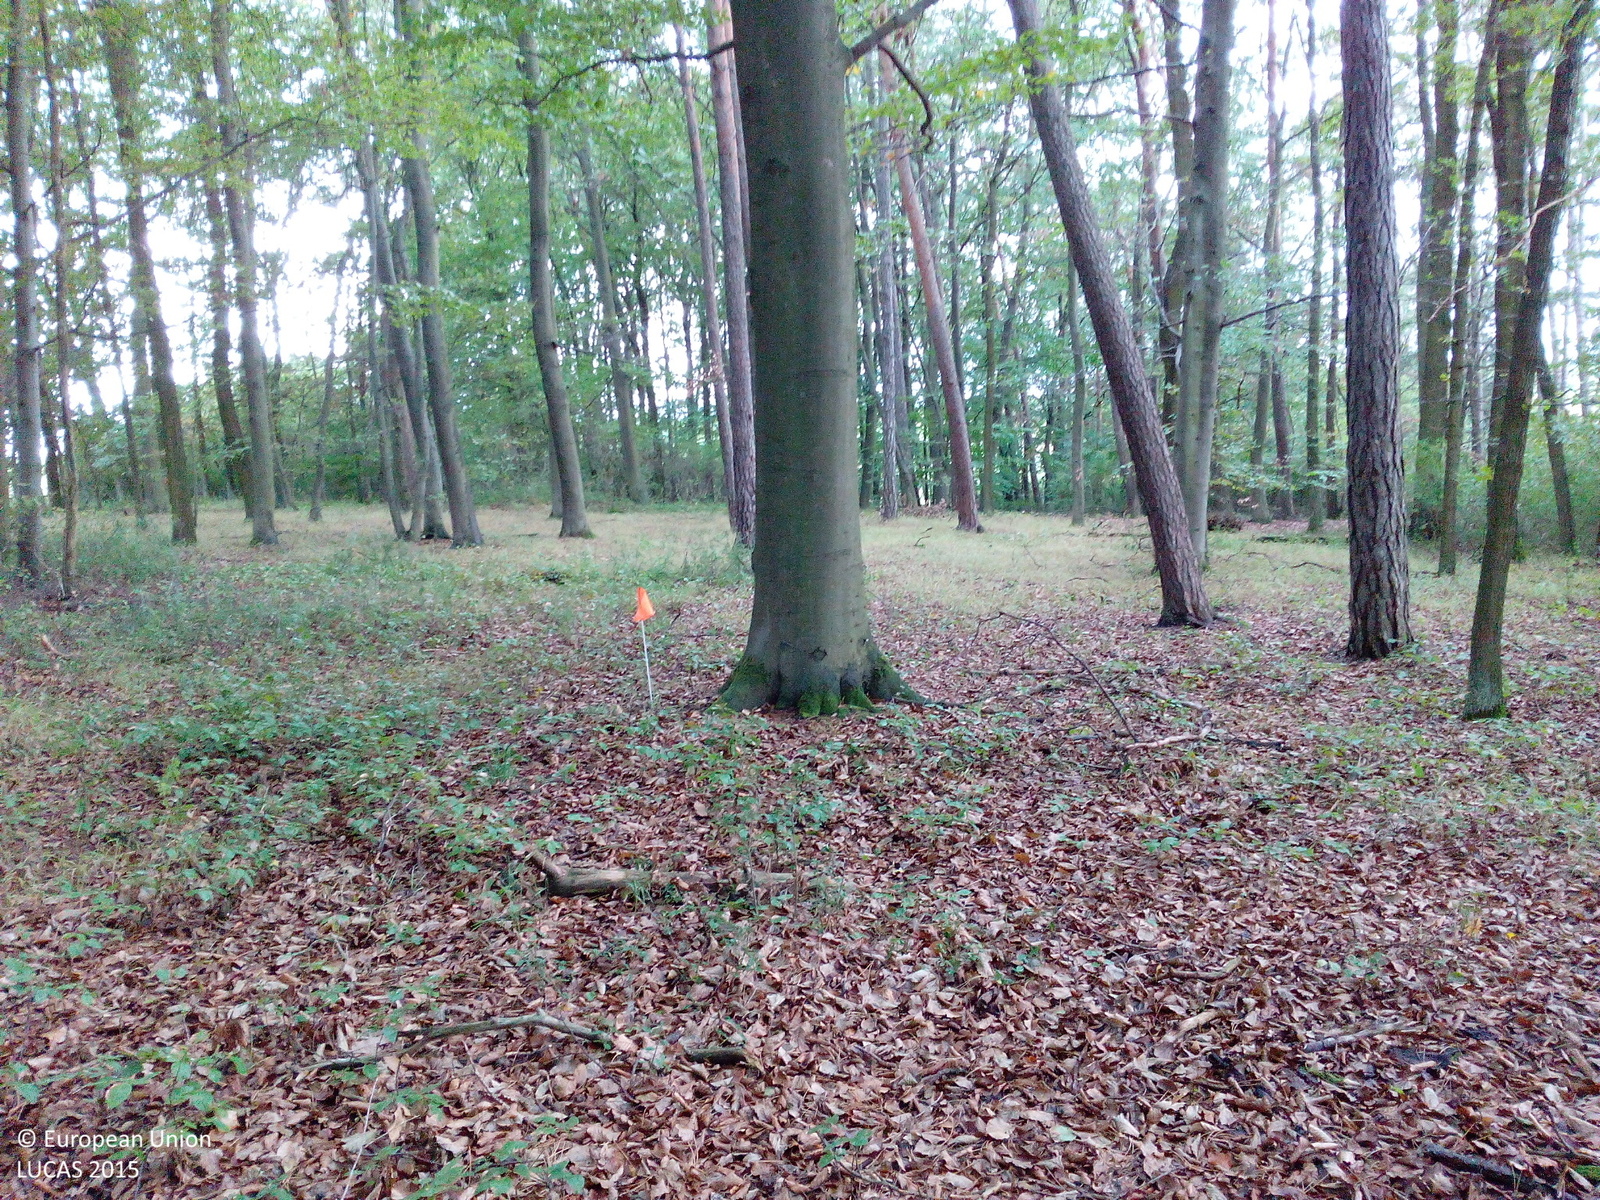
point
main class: Woodland
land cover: Pine dominated mixed woodland
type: hemiboreal forest and nemoral coniferous forest and mixed broadleaved-coniferous forest
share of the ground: > 75 %
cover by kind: broadleaved forest trees 45 %, coniferous forest trees 35 %, herbaceous plants 10 %, unconsolidated bare surface 10 %
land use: Forestry
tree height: > 5 m
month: September
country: DE
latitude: 49.9324
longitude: 9.9025
